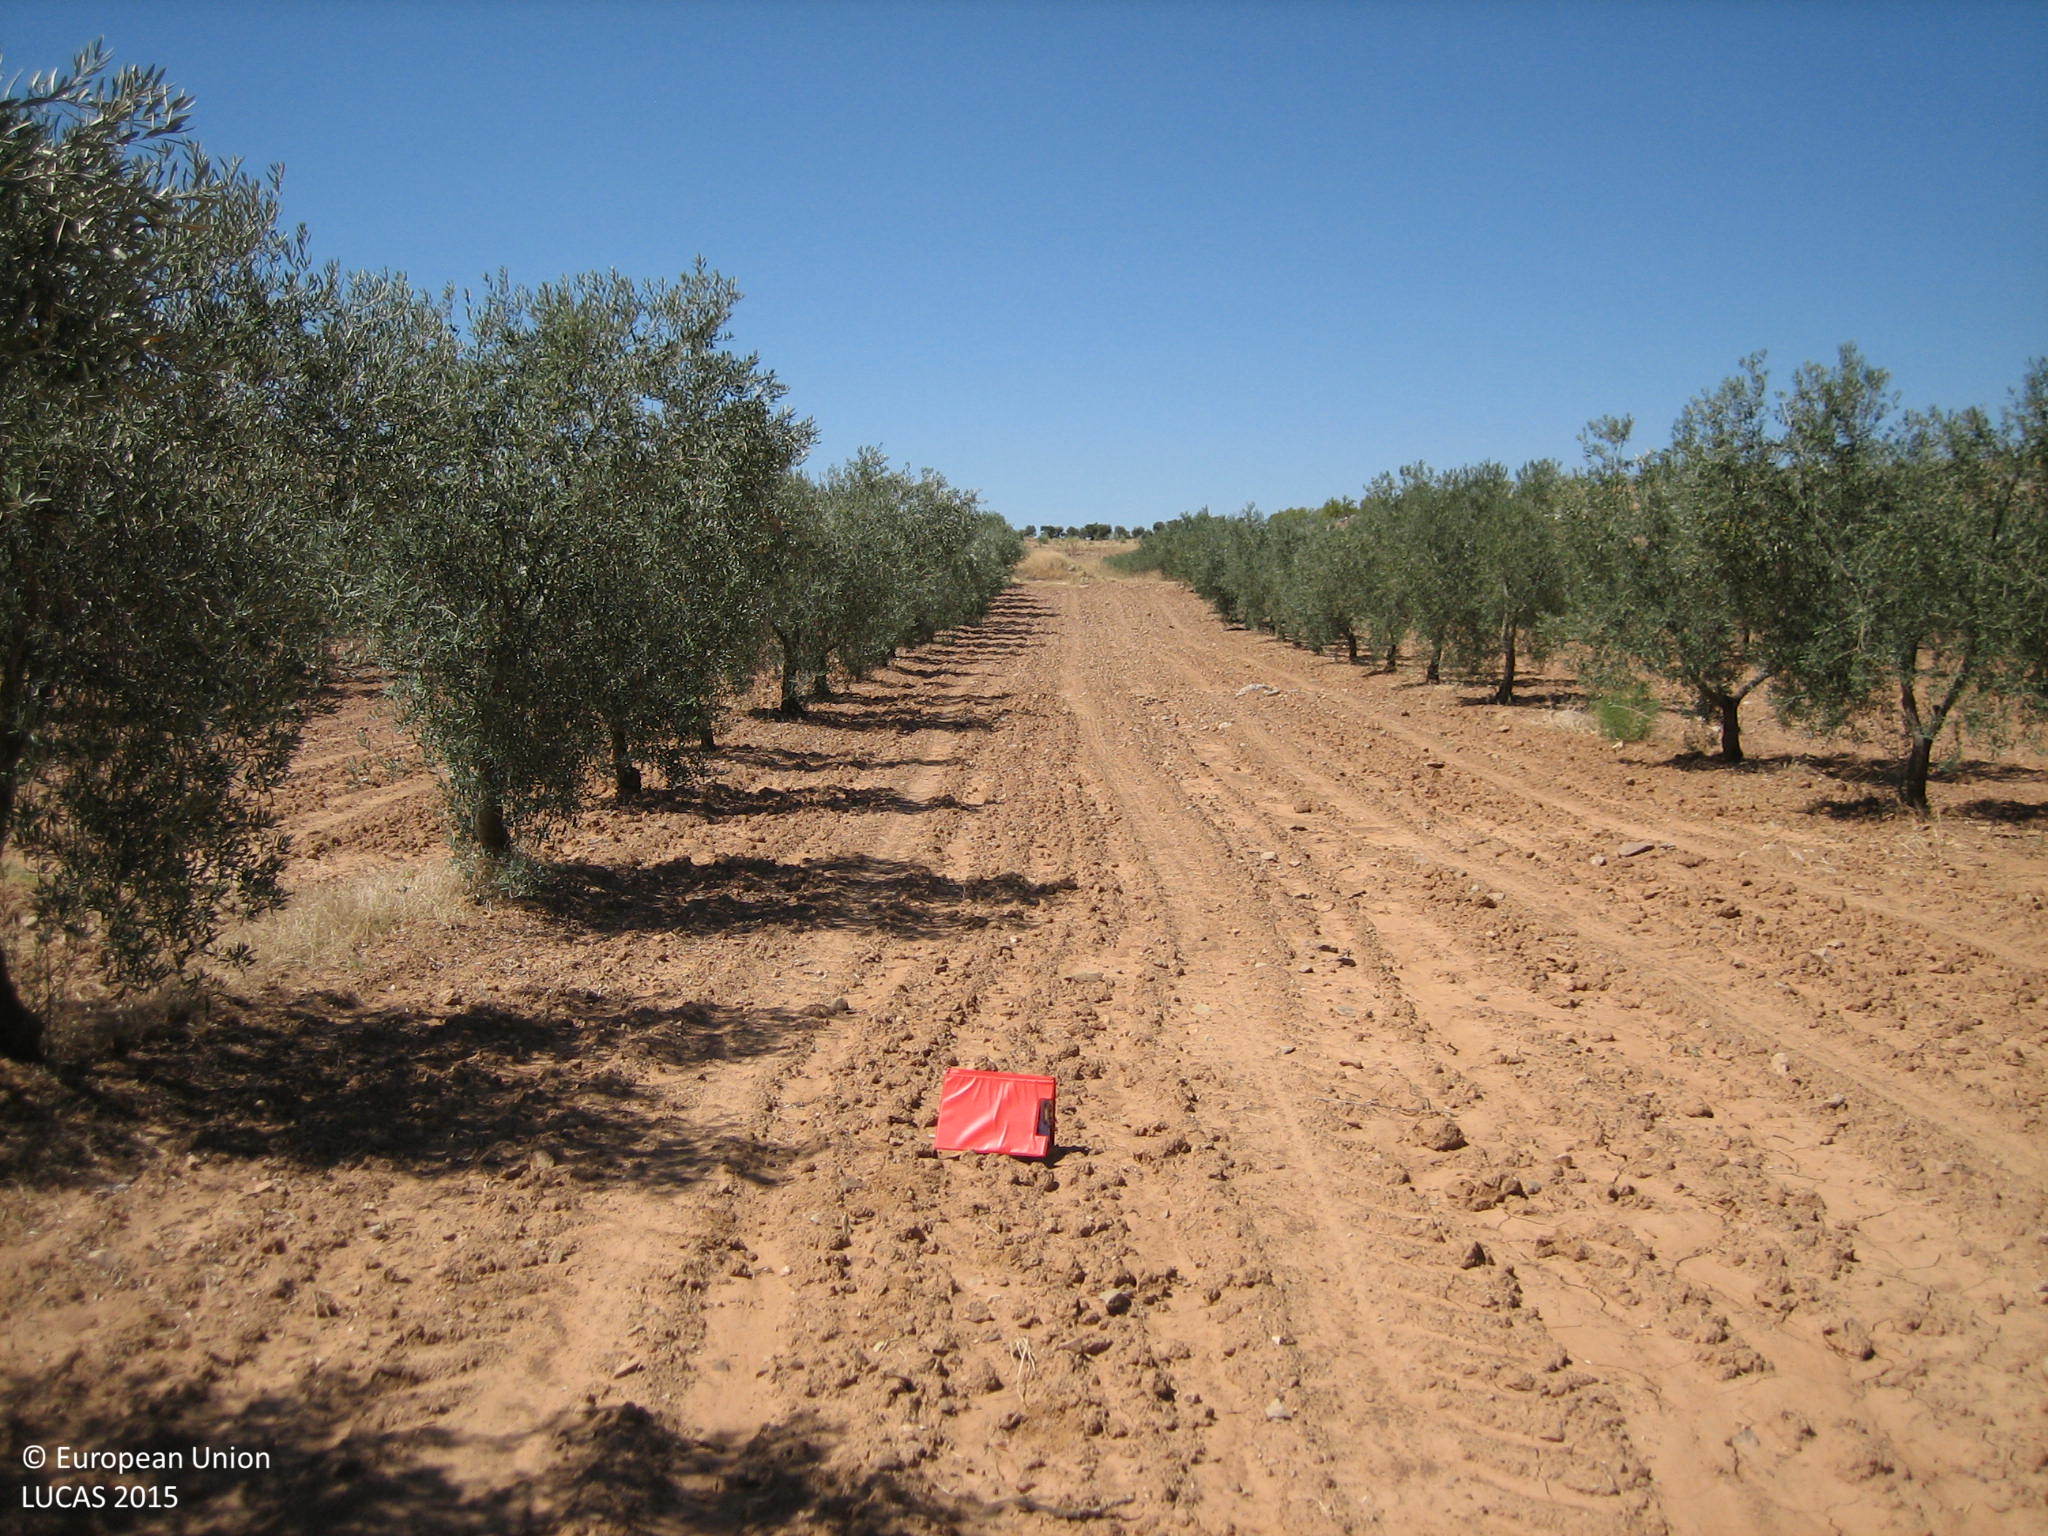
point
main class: Cropland
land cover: Olive groves
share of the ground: 25 - 50 %
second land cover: Other bare soil
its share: > 75 %
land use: Agriculture (excluding fallow land and kitchen gardens)
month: July
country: ES
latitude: 38.4287
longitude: -6.3264
